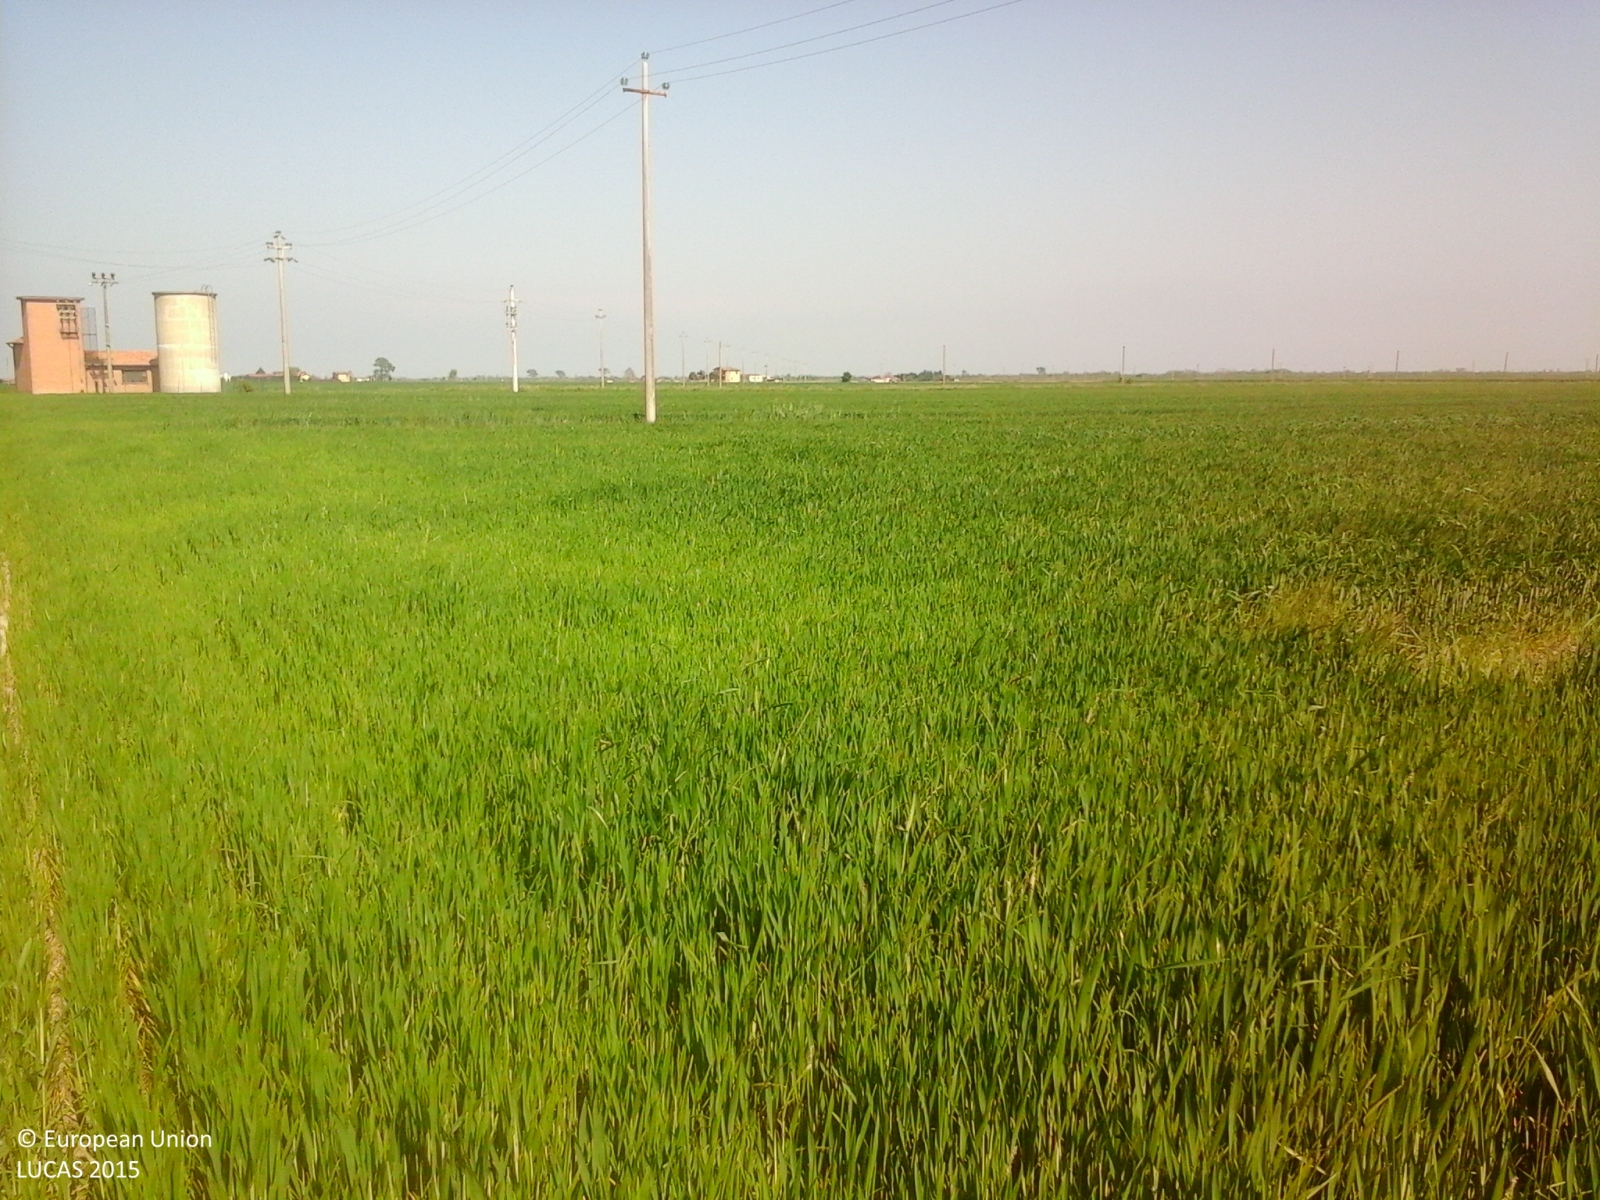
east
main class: Cropland
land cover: Common wheat
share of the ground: > 75 %
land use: Agriculture (excluding fallow land and kitchen gardens)
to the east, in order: Common wheat; Ditches and canals; Common wheat; Ditches and canals; Common wheat; Ditches and canals; Common wheat; Ditches and canals; Common wheat; Ditches and canals; Grass margins; Paved roads, cycling and walking lanes; Grass margins; Electric lines; Ditches and canals; Common wheat
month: April
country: IT
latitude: 45.0287
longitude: 12.2932
